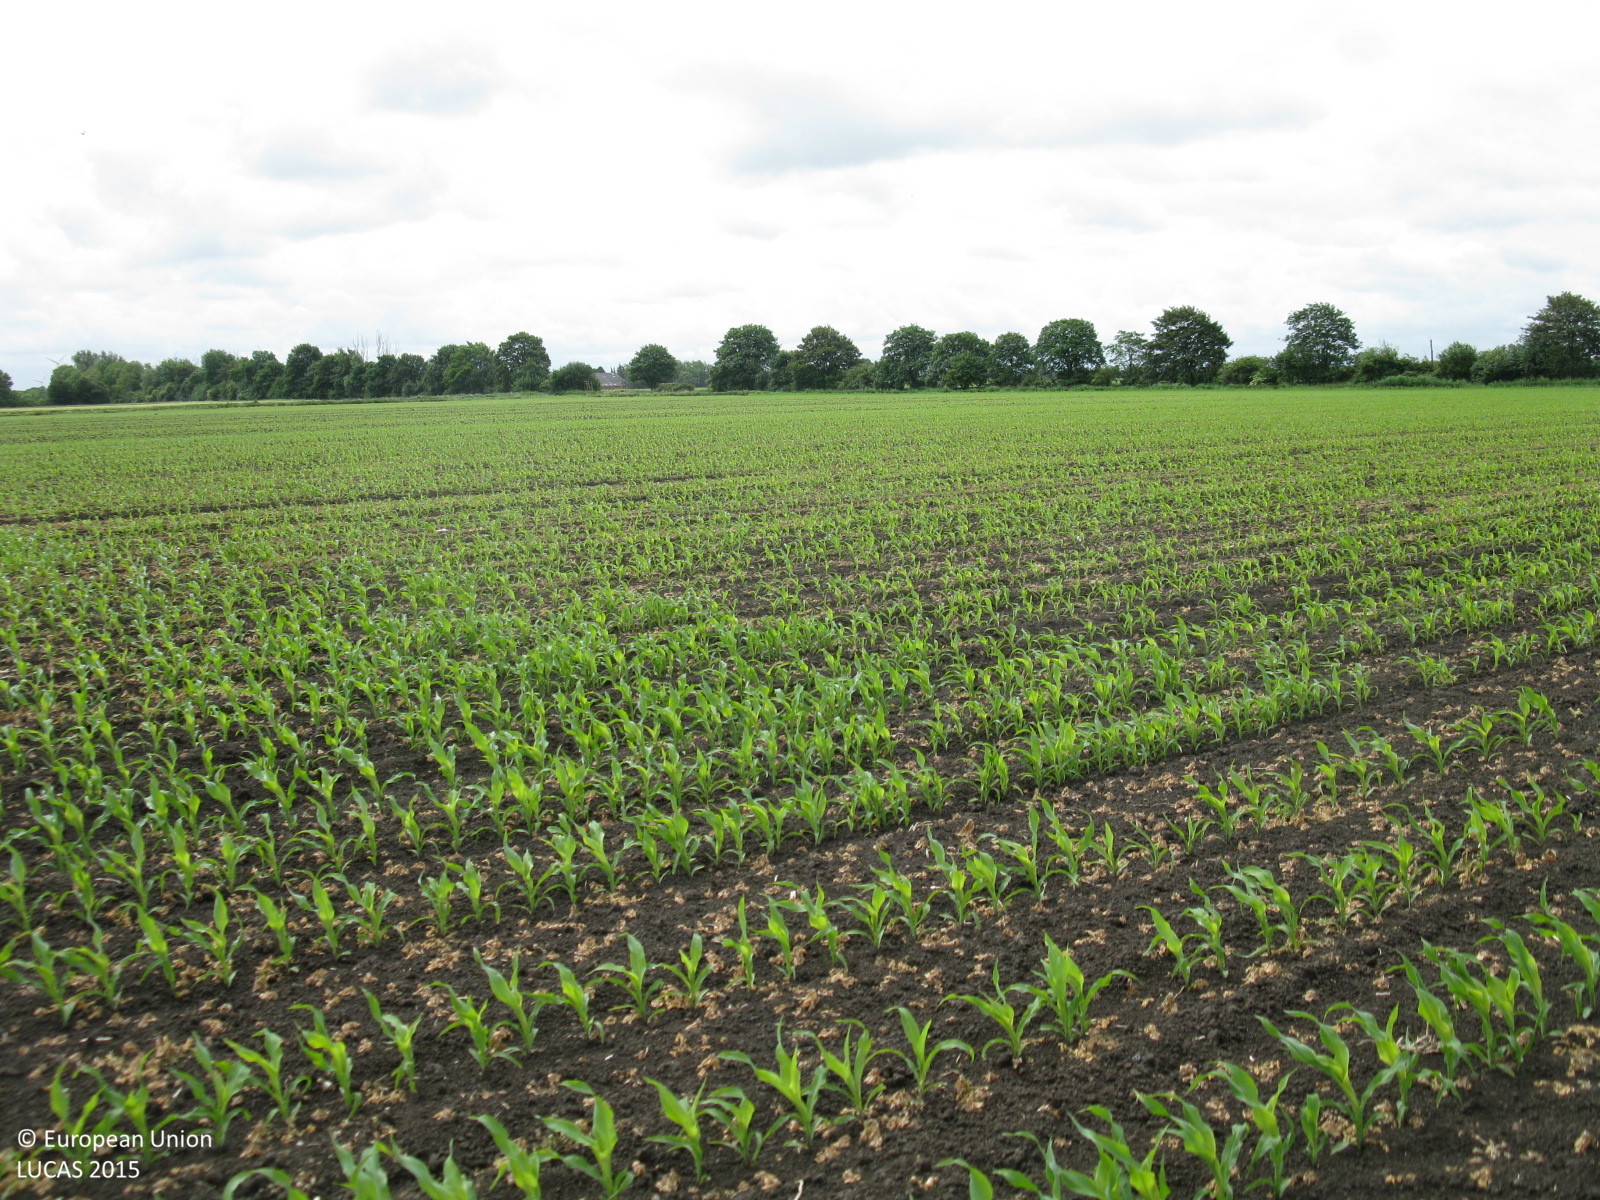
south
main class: Cropland
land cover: Maize
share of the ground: 10 - 25 %
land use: Agriculture (excluding fallow land and kitchen gardens)
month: June
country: DE
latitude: 53.4087
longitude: 7.3380
